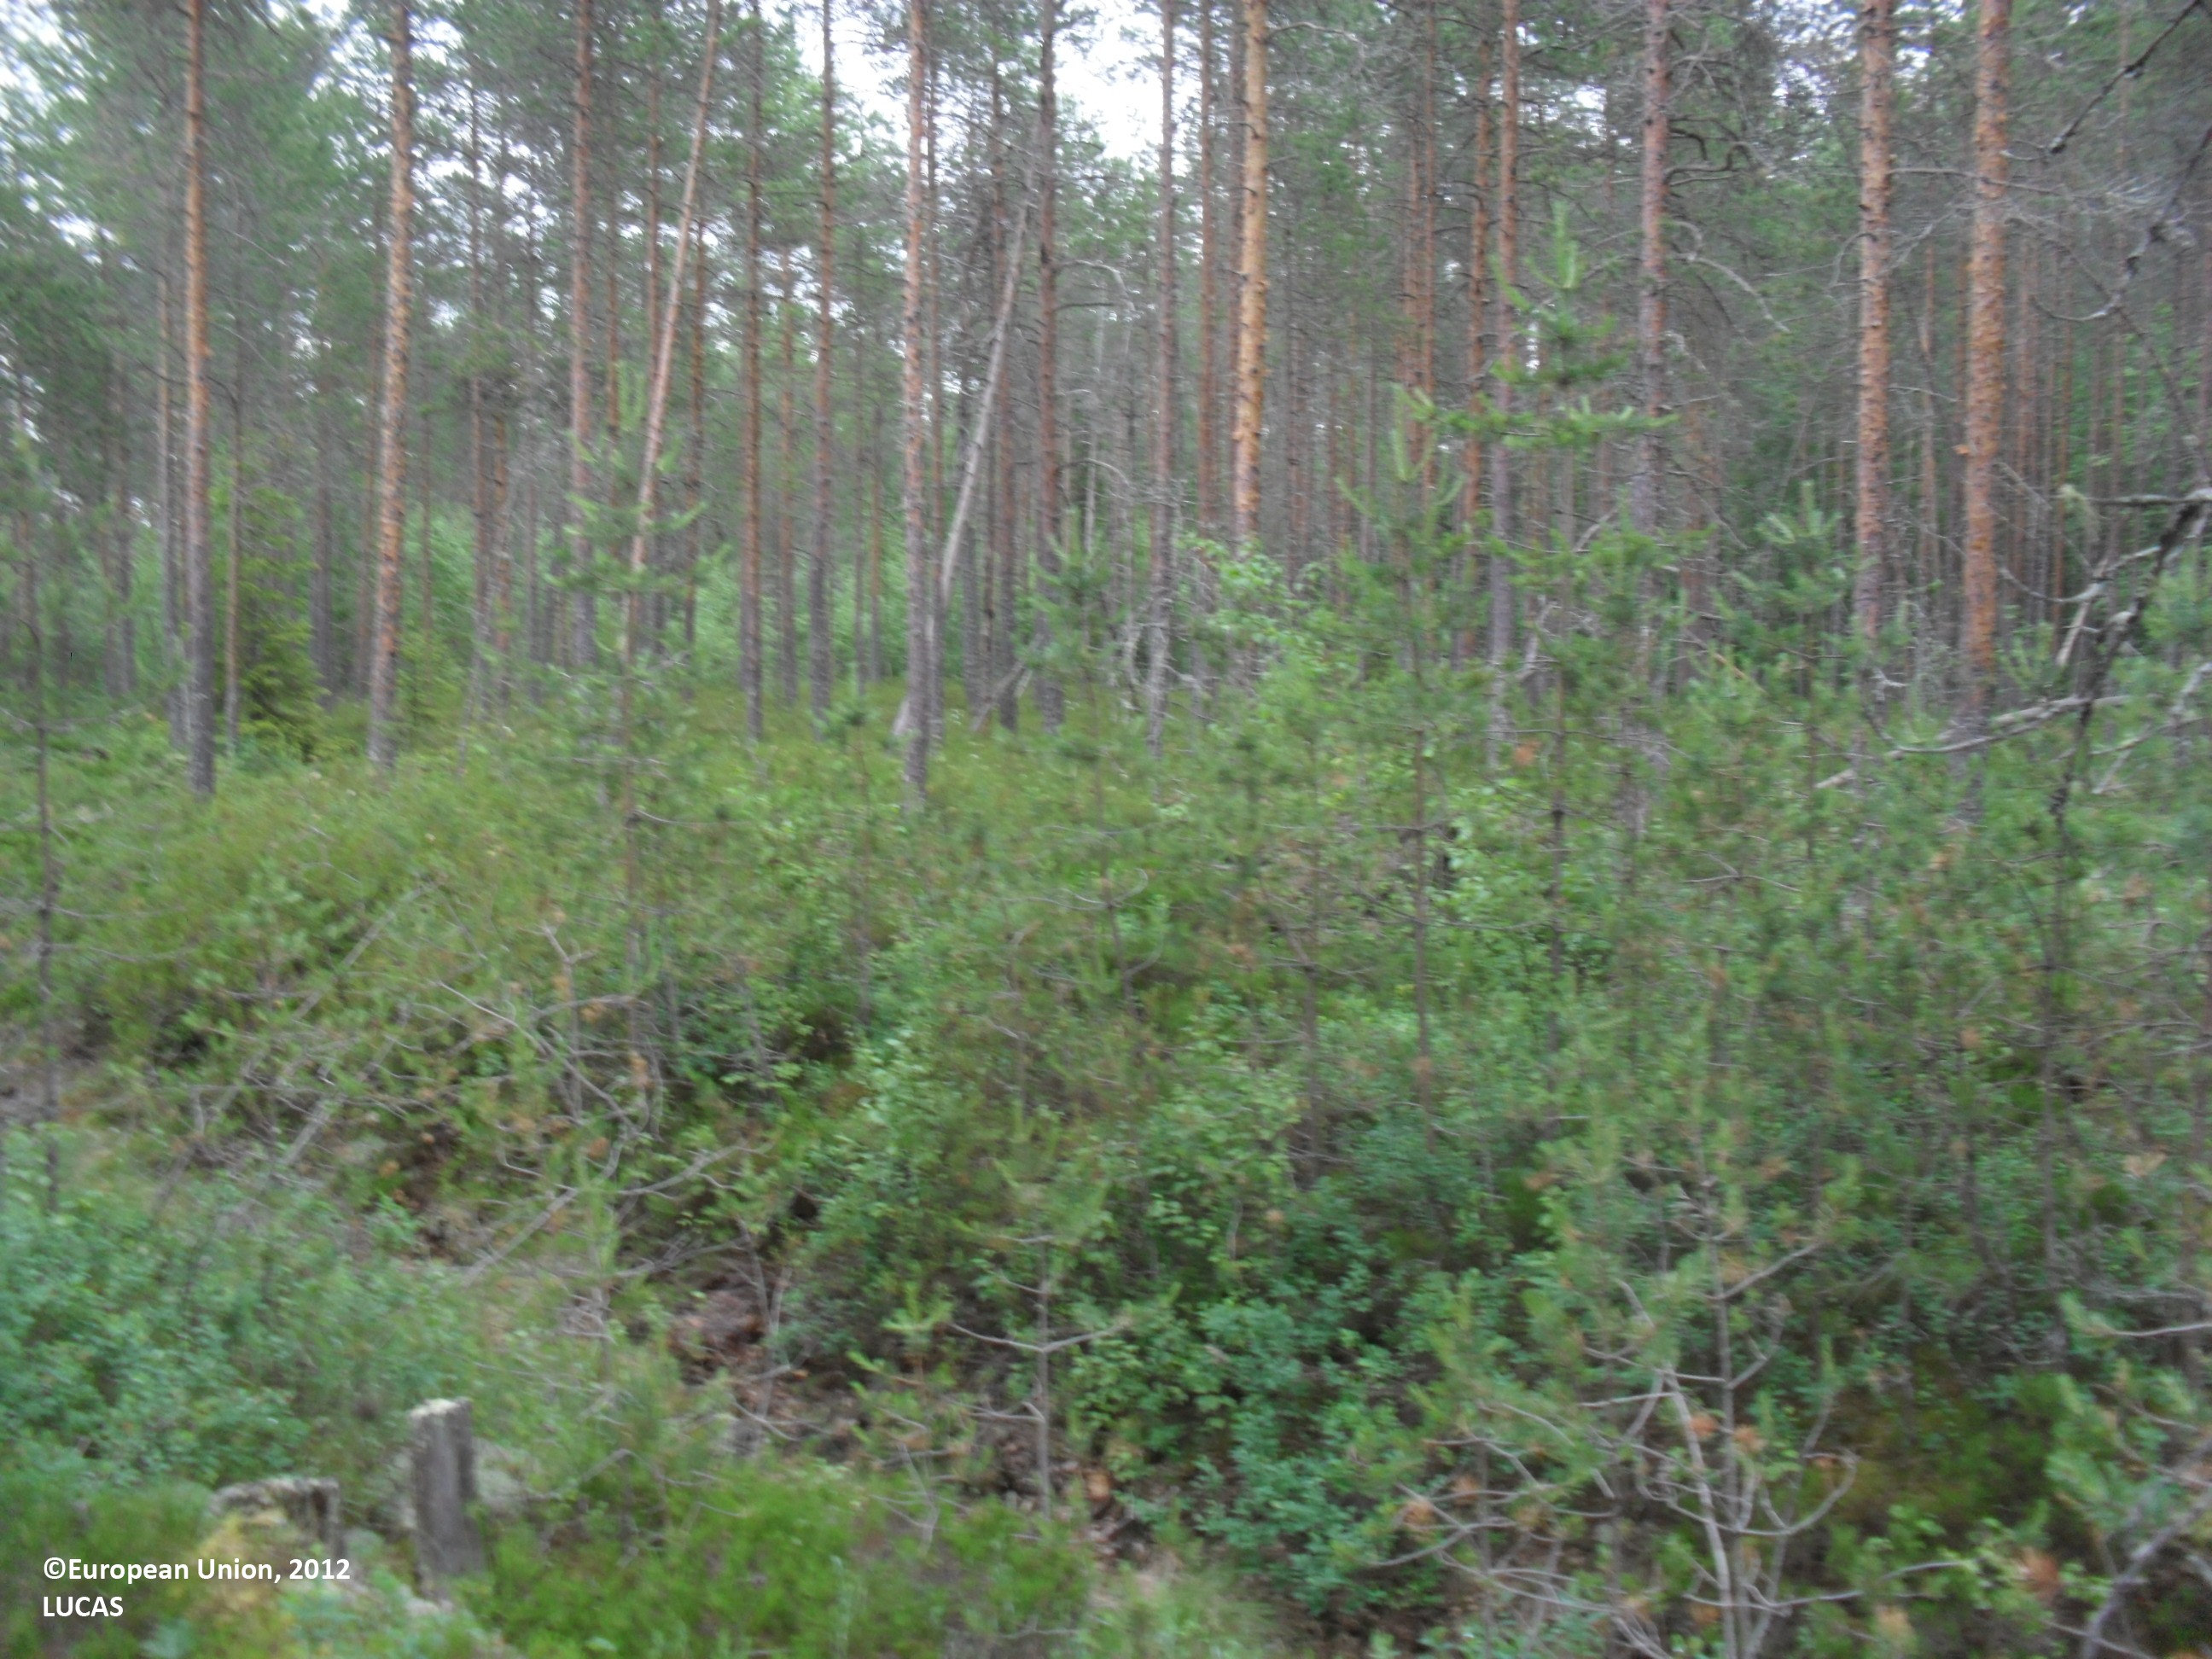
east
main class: Woodland
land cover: Pine dominated coniferous woodland
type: mire and swamp forests
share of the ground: 25 - 50 %
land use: Forestry
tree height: > 5 m
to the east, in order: Pine dominated coniferous woodland; Ditches and canals; Pine dominated coniferous woodland; Ditches and canals; Other mixed woodland; Broadleaved woodland; Other mixed woodland; Pine dominated mixed woodland; Broadleaved woodland
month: July
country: FI
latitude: 63.5760
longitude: 23.5363
